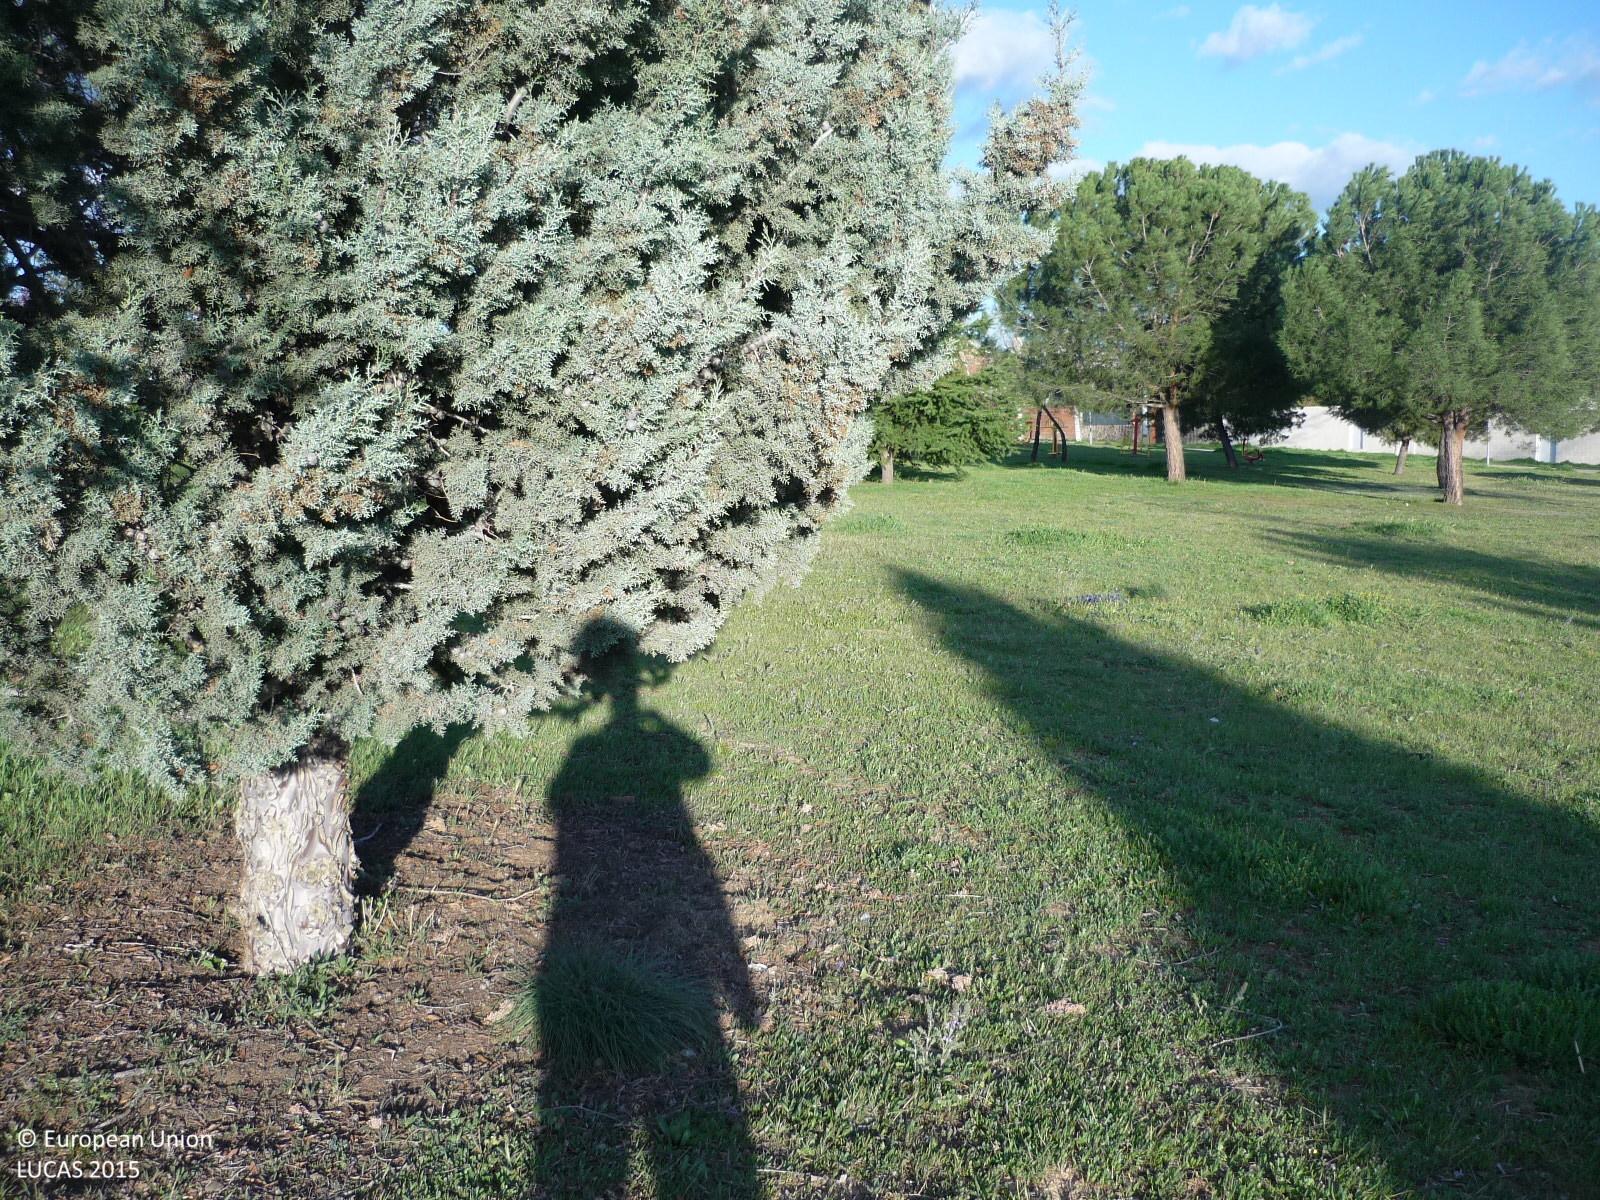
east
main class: Woodland
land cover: Other mixed woodland
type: coniferous forest of the mediterranean region
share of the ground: 25 - 50 %
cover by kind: herbaceous plants 70 %, coniferous forest trees 20 %, broadleaved forest trees 10 %
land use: Residential
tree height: < 5 m
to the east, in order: Other mixed woodland; Artificial constructions in urban areas
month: March
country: ES
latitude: 40.4464
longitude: -3.3685
